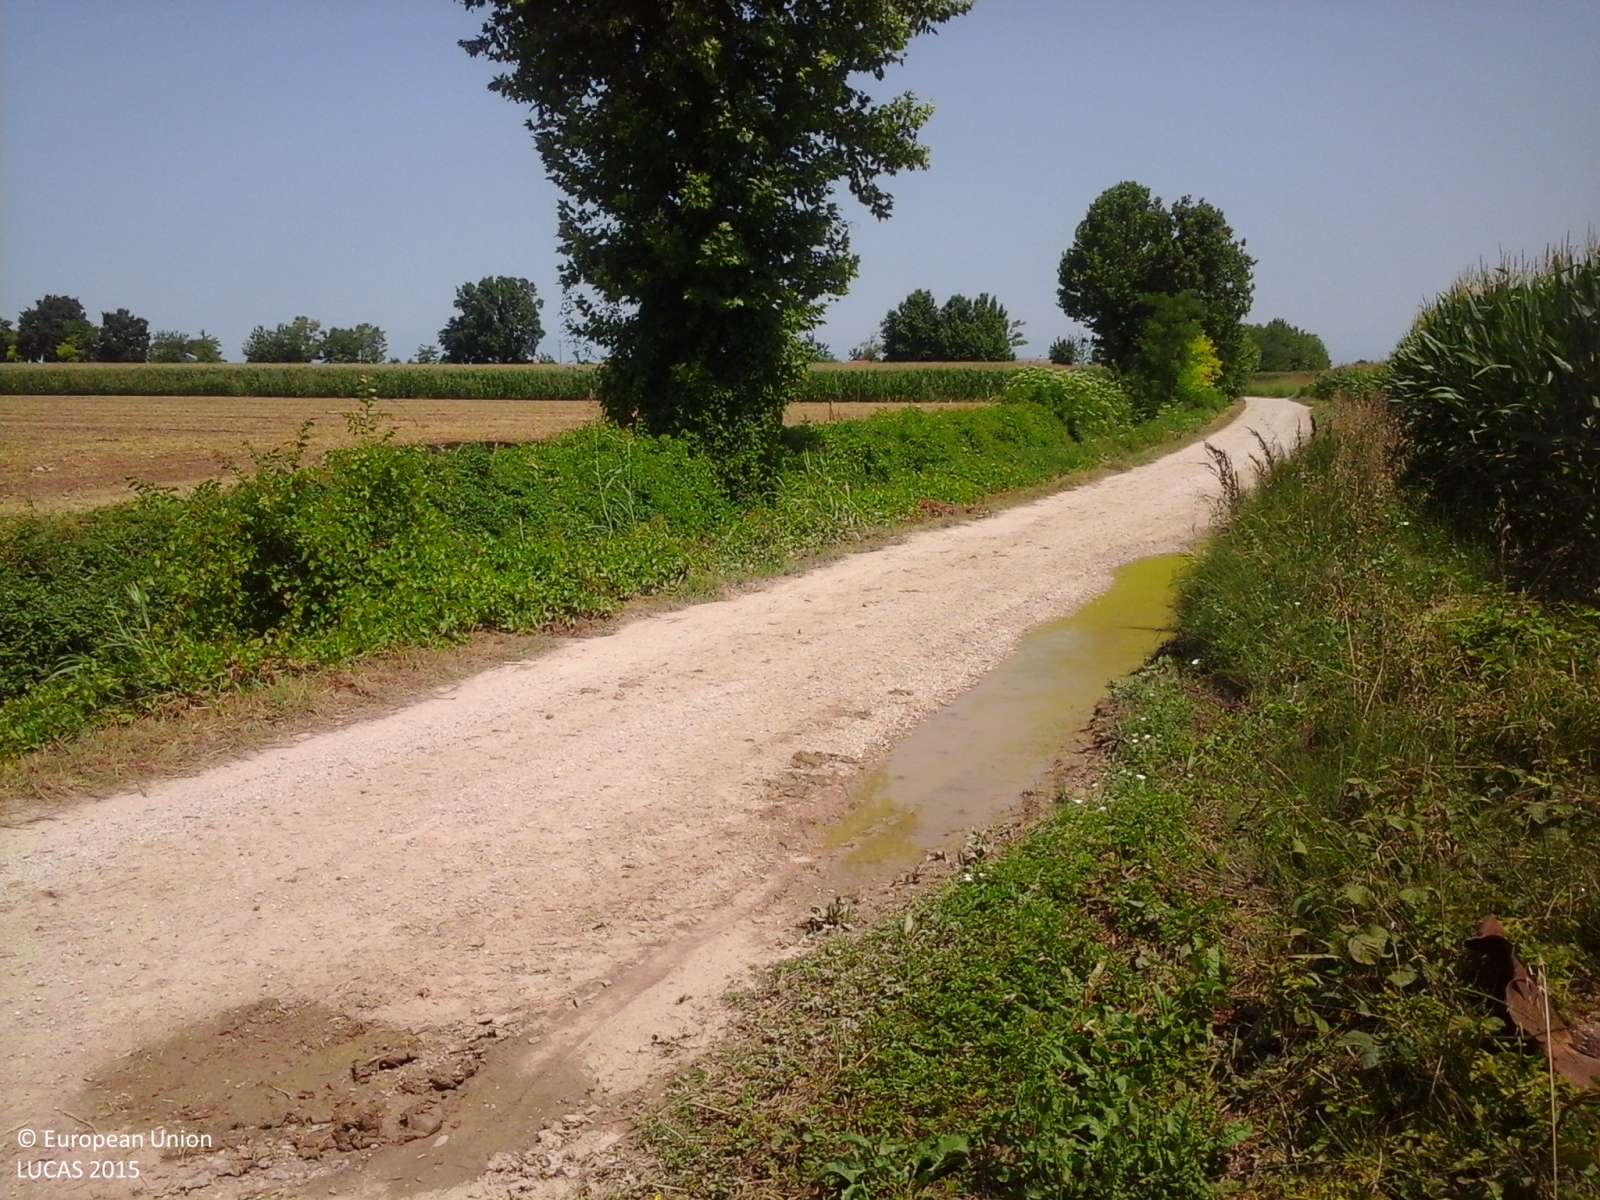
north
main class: Cropland
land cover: Maize
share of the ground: > 75 %
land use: Agriculture (excluding fallow land and kitchen gardens)
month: July
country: IT
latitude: 45.2662
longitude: 10.9033
